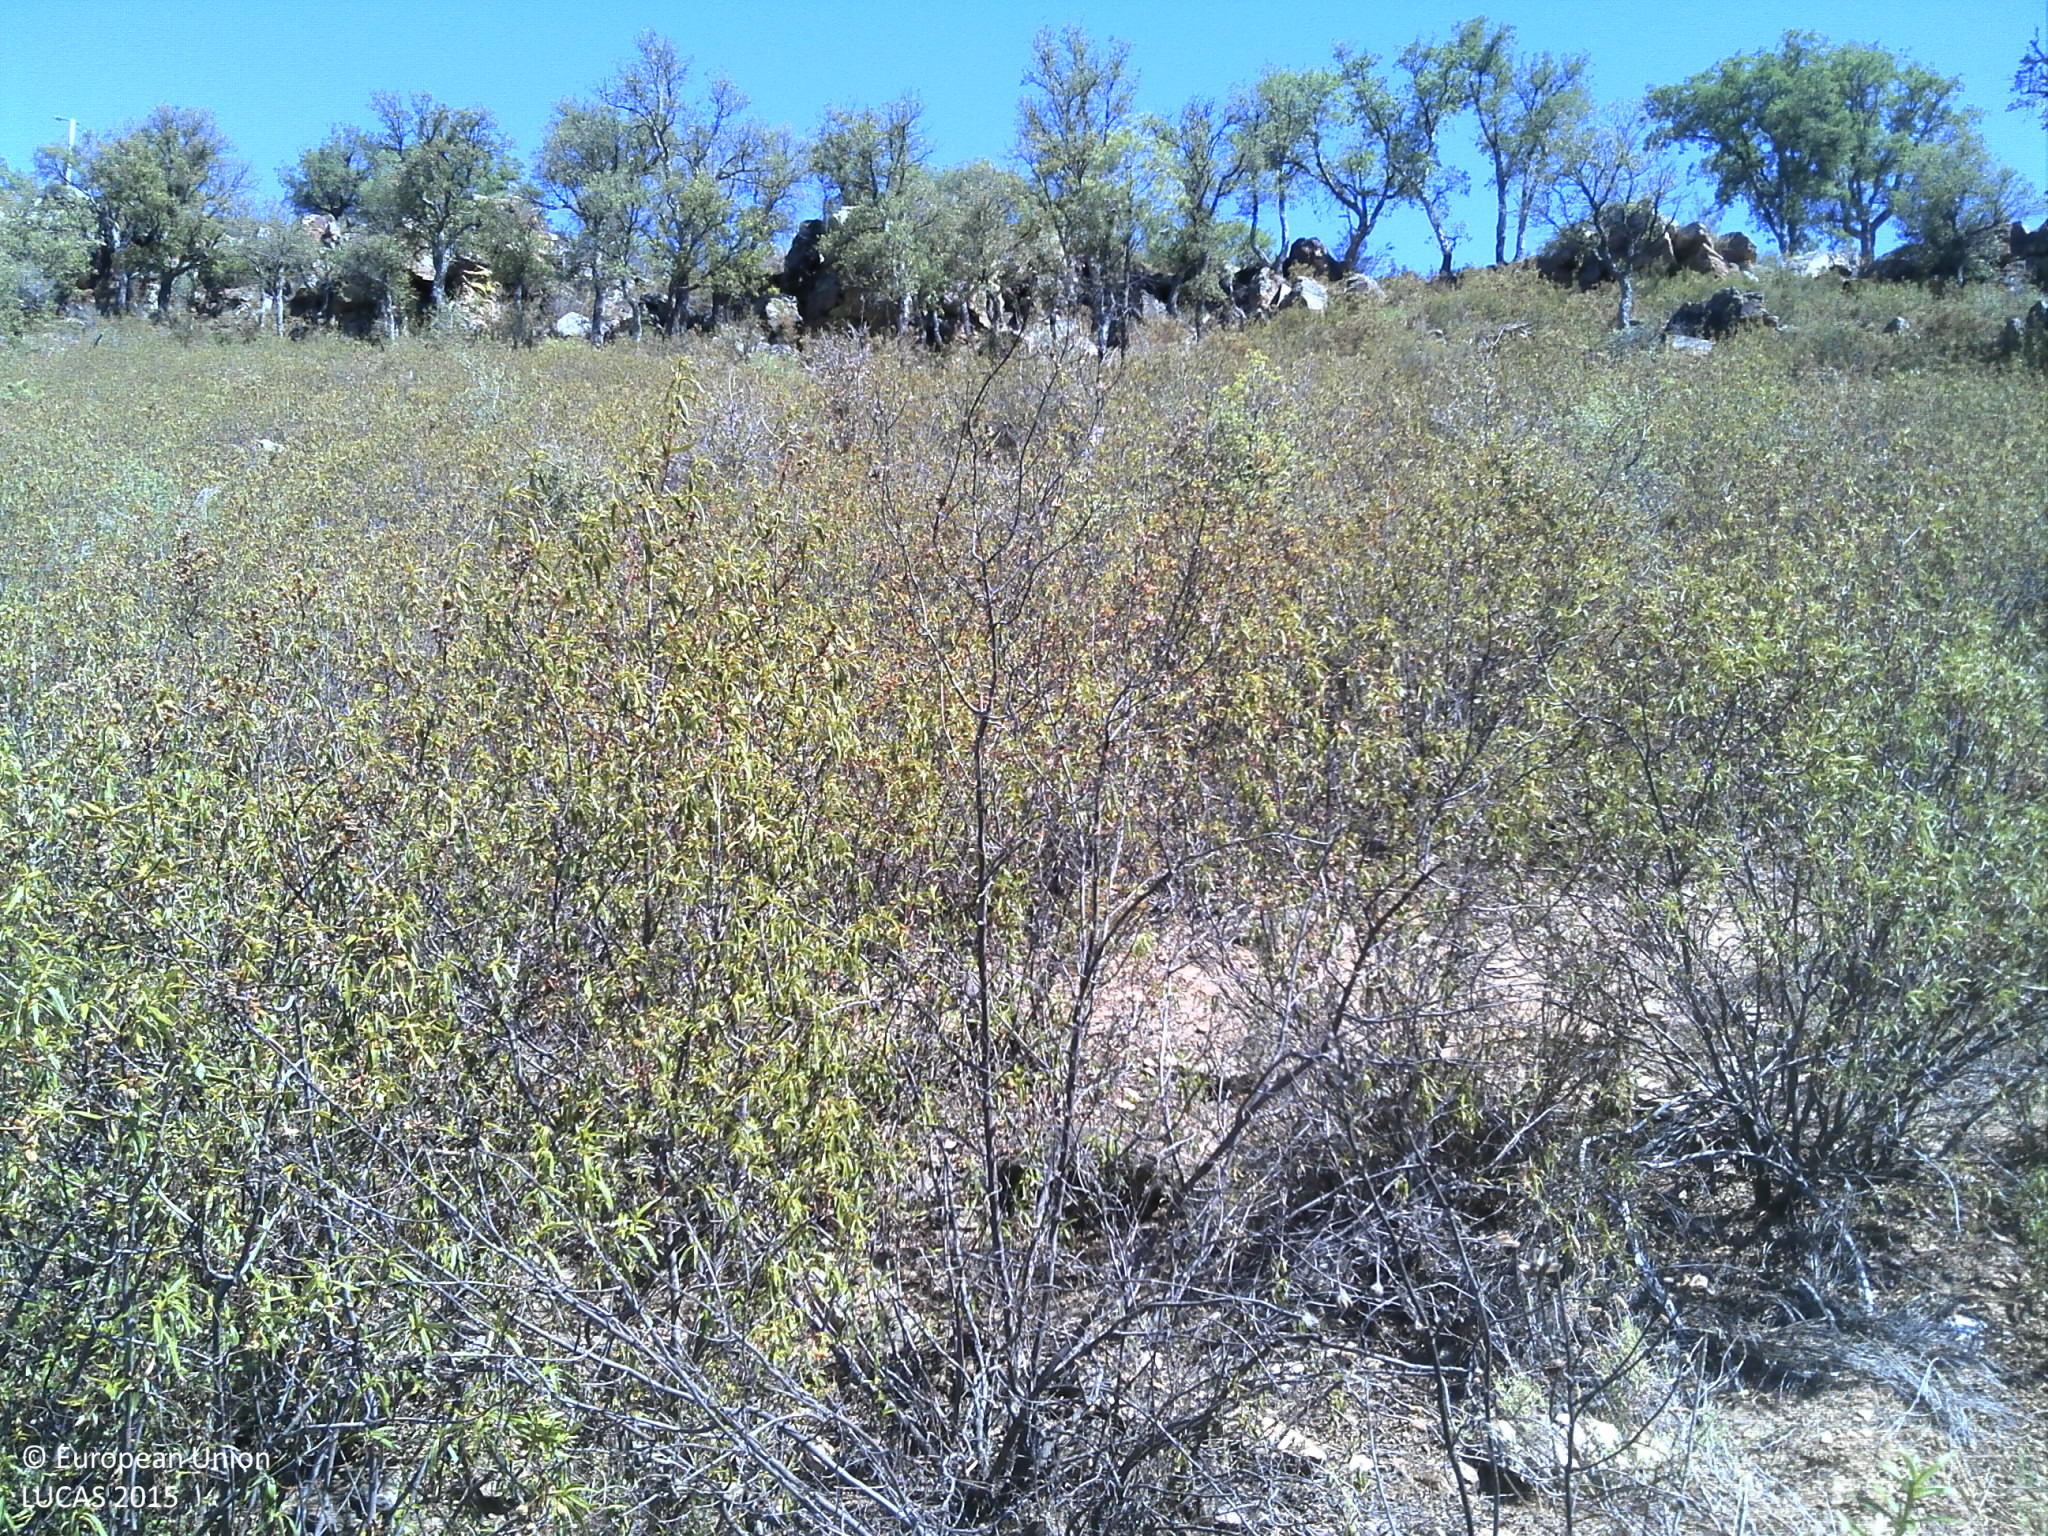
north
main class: Shrubland
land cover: Shrubland with sparse tree cover
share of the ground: > 75 %
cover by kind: shrubs 95 %, broadleaved forest trees 5 %
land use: Semi-natural and natural areas not in use
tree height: > 5 m
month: July
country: PT
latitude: 41.4016
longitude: -7.1375
